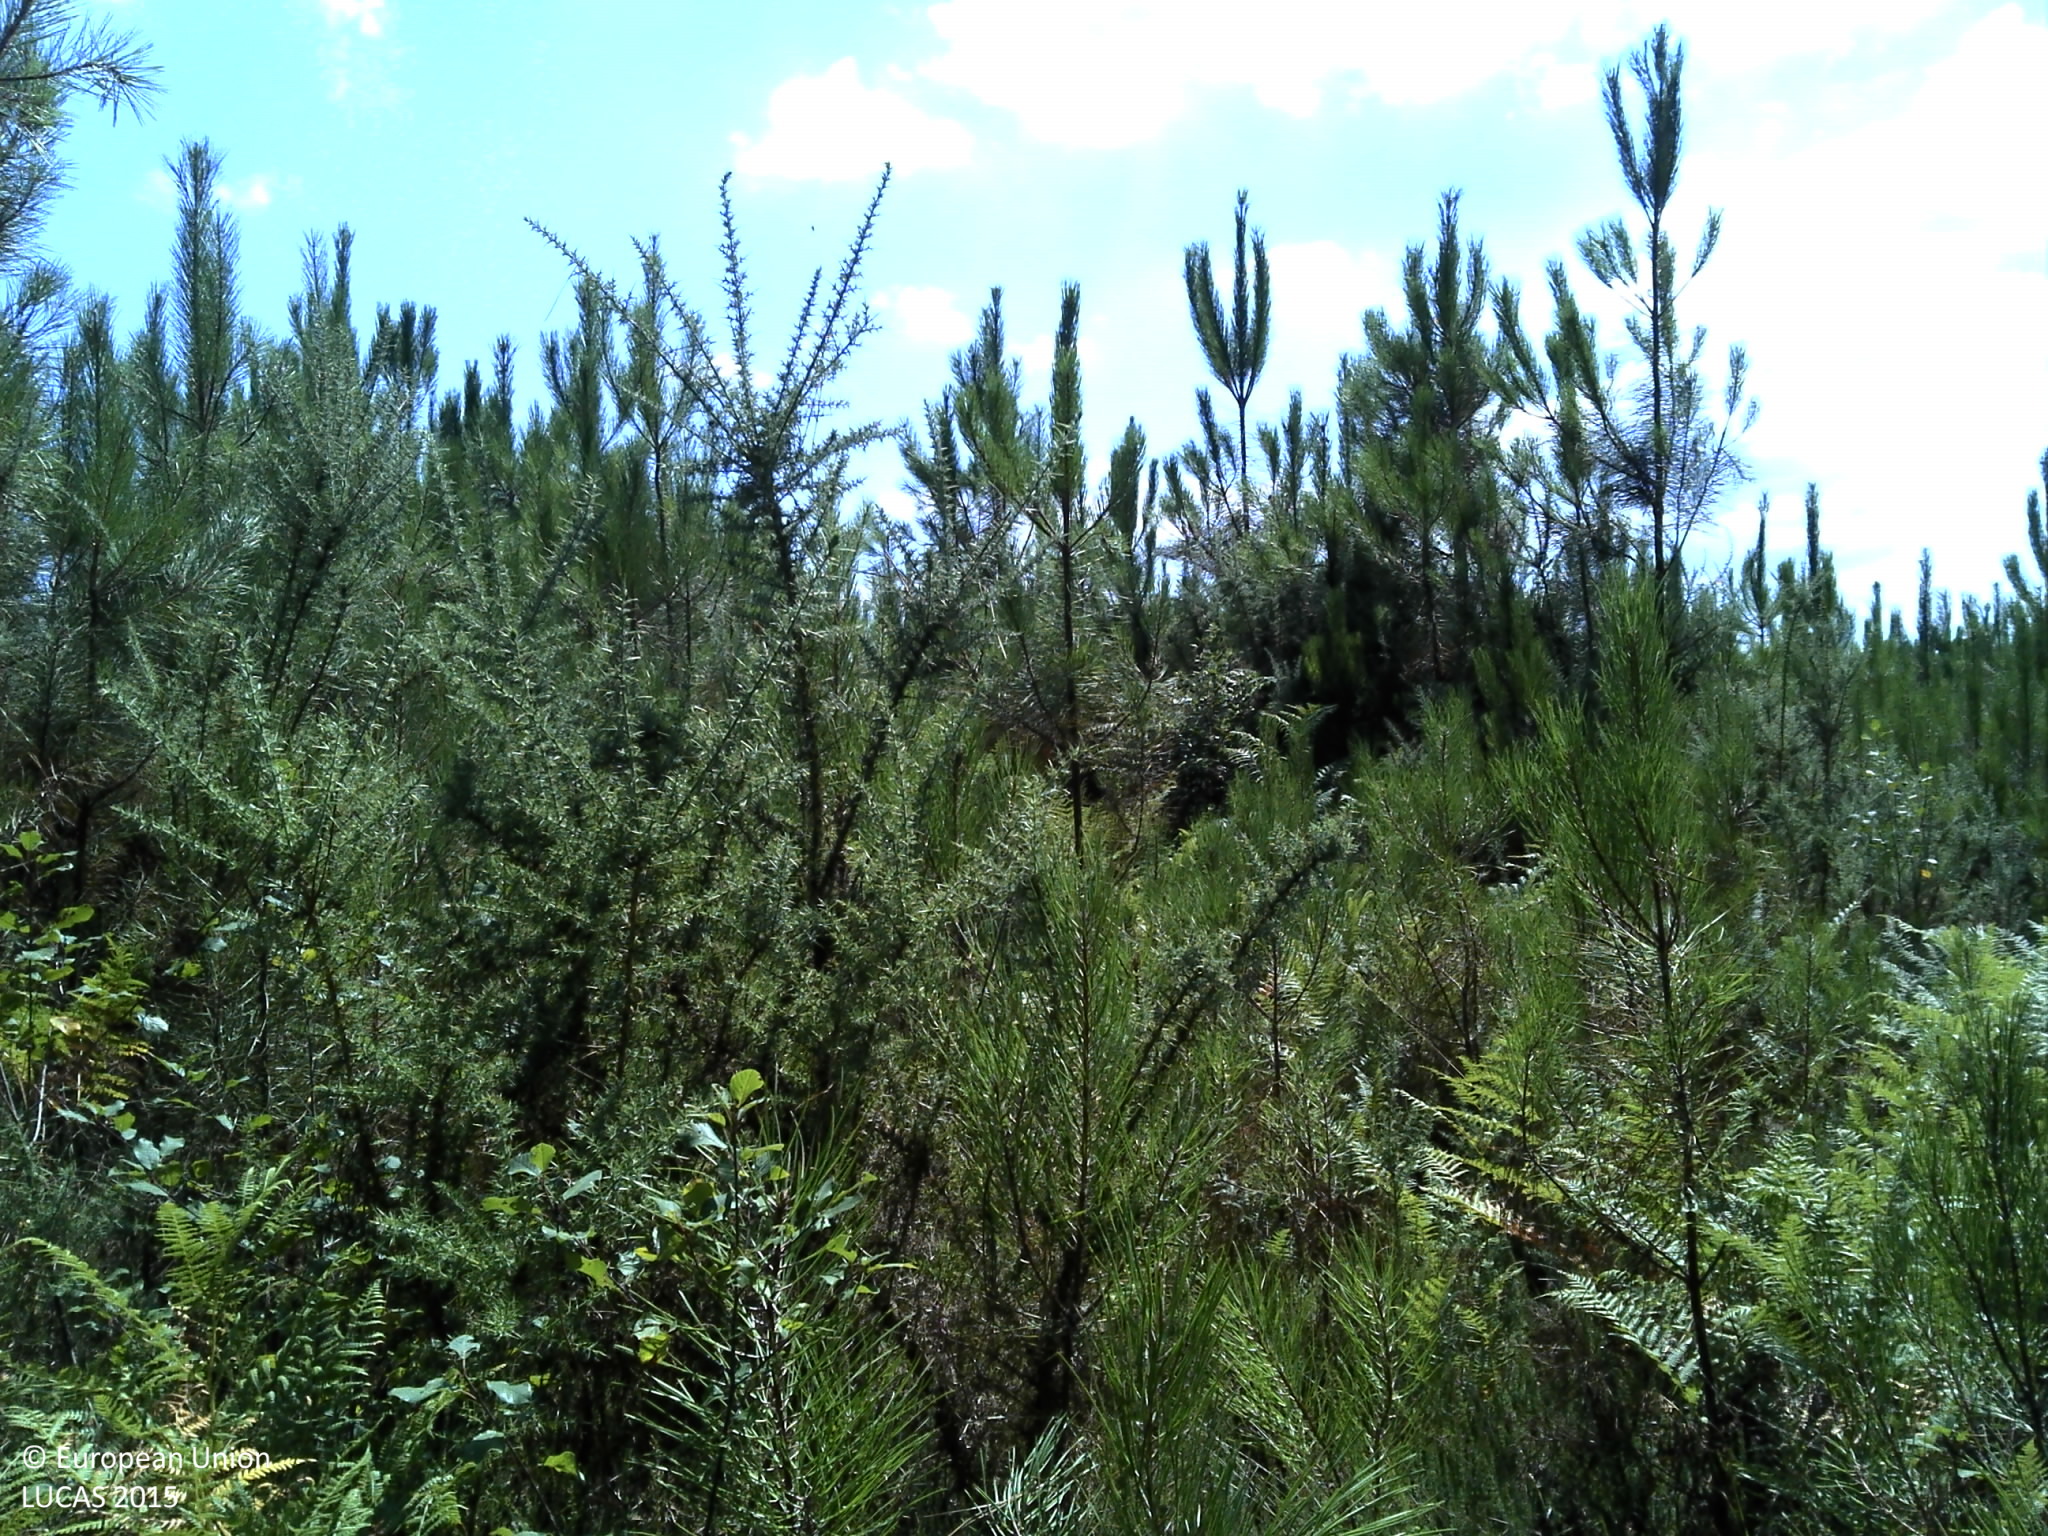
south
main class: Woodland
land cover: Pine dominated coniferous woodland
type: coniferous forest of the mediterranean region
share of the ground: > 75 %
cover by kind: coniferous forest trees 80 %, shrubs 20 %
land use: Forestry
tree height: < 5 m
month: August
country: FR
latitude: 45.0118
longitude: -0.7173
